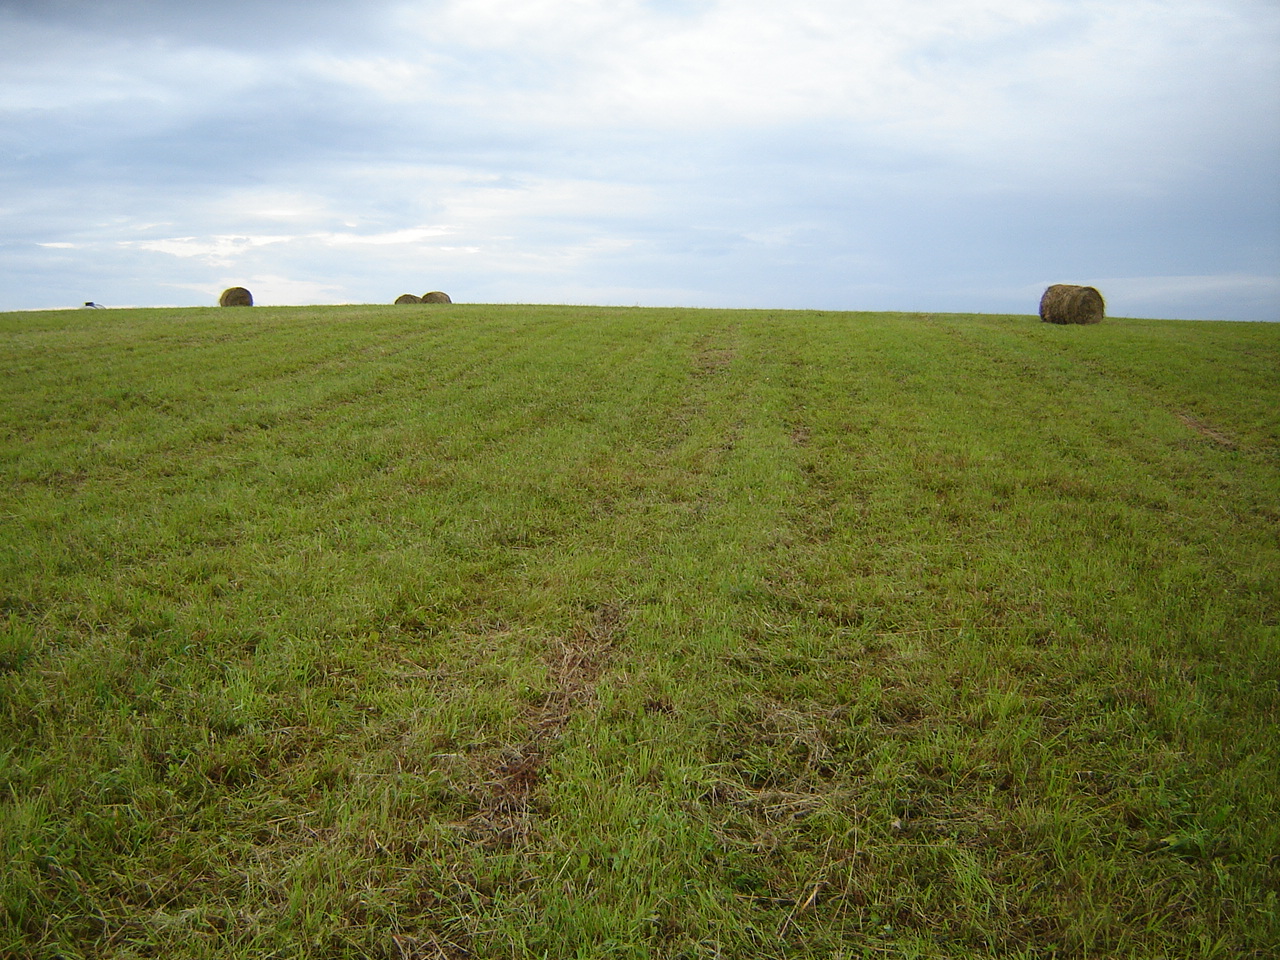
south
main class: Grassland
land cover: Grassland without tree/shrub cover
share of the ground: > 75 %
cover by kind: herbaceous plants 100 %
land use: Agriculture (excluding fallow land and kitchen gardens)
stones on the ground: < 10 %
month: July
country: LT
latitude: 55.4218
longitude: 25.0435
